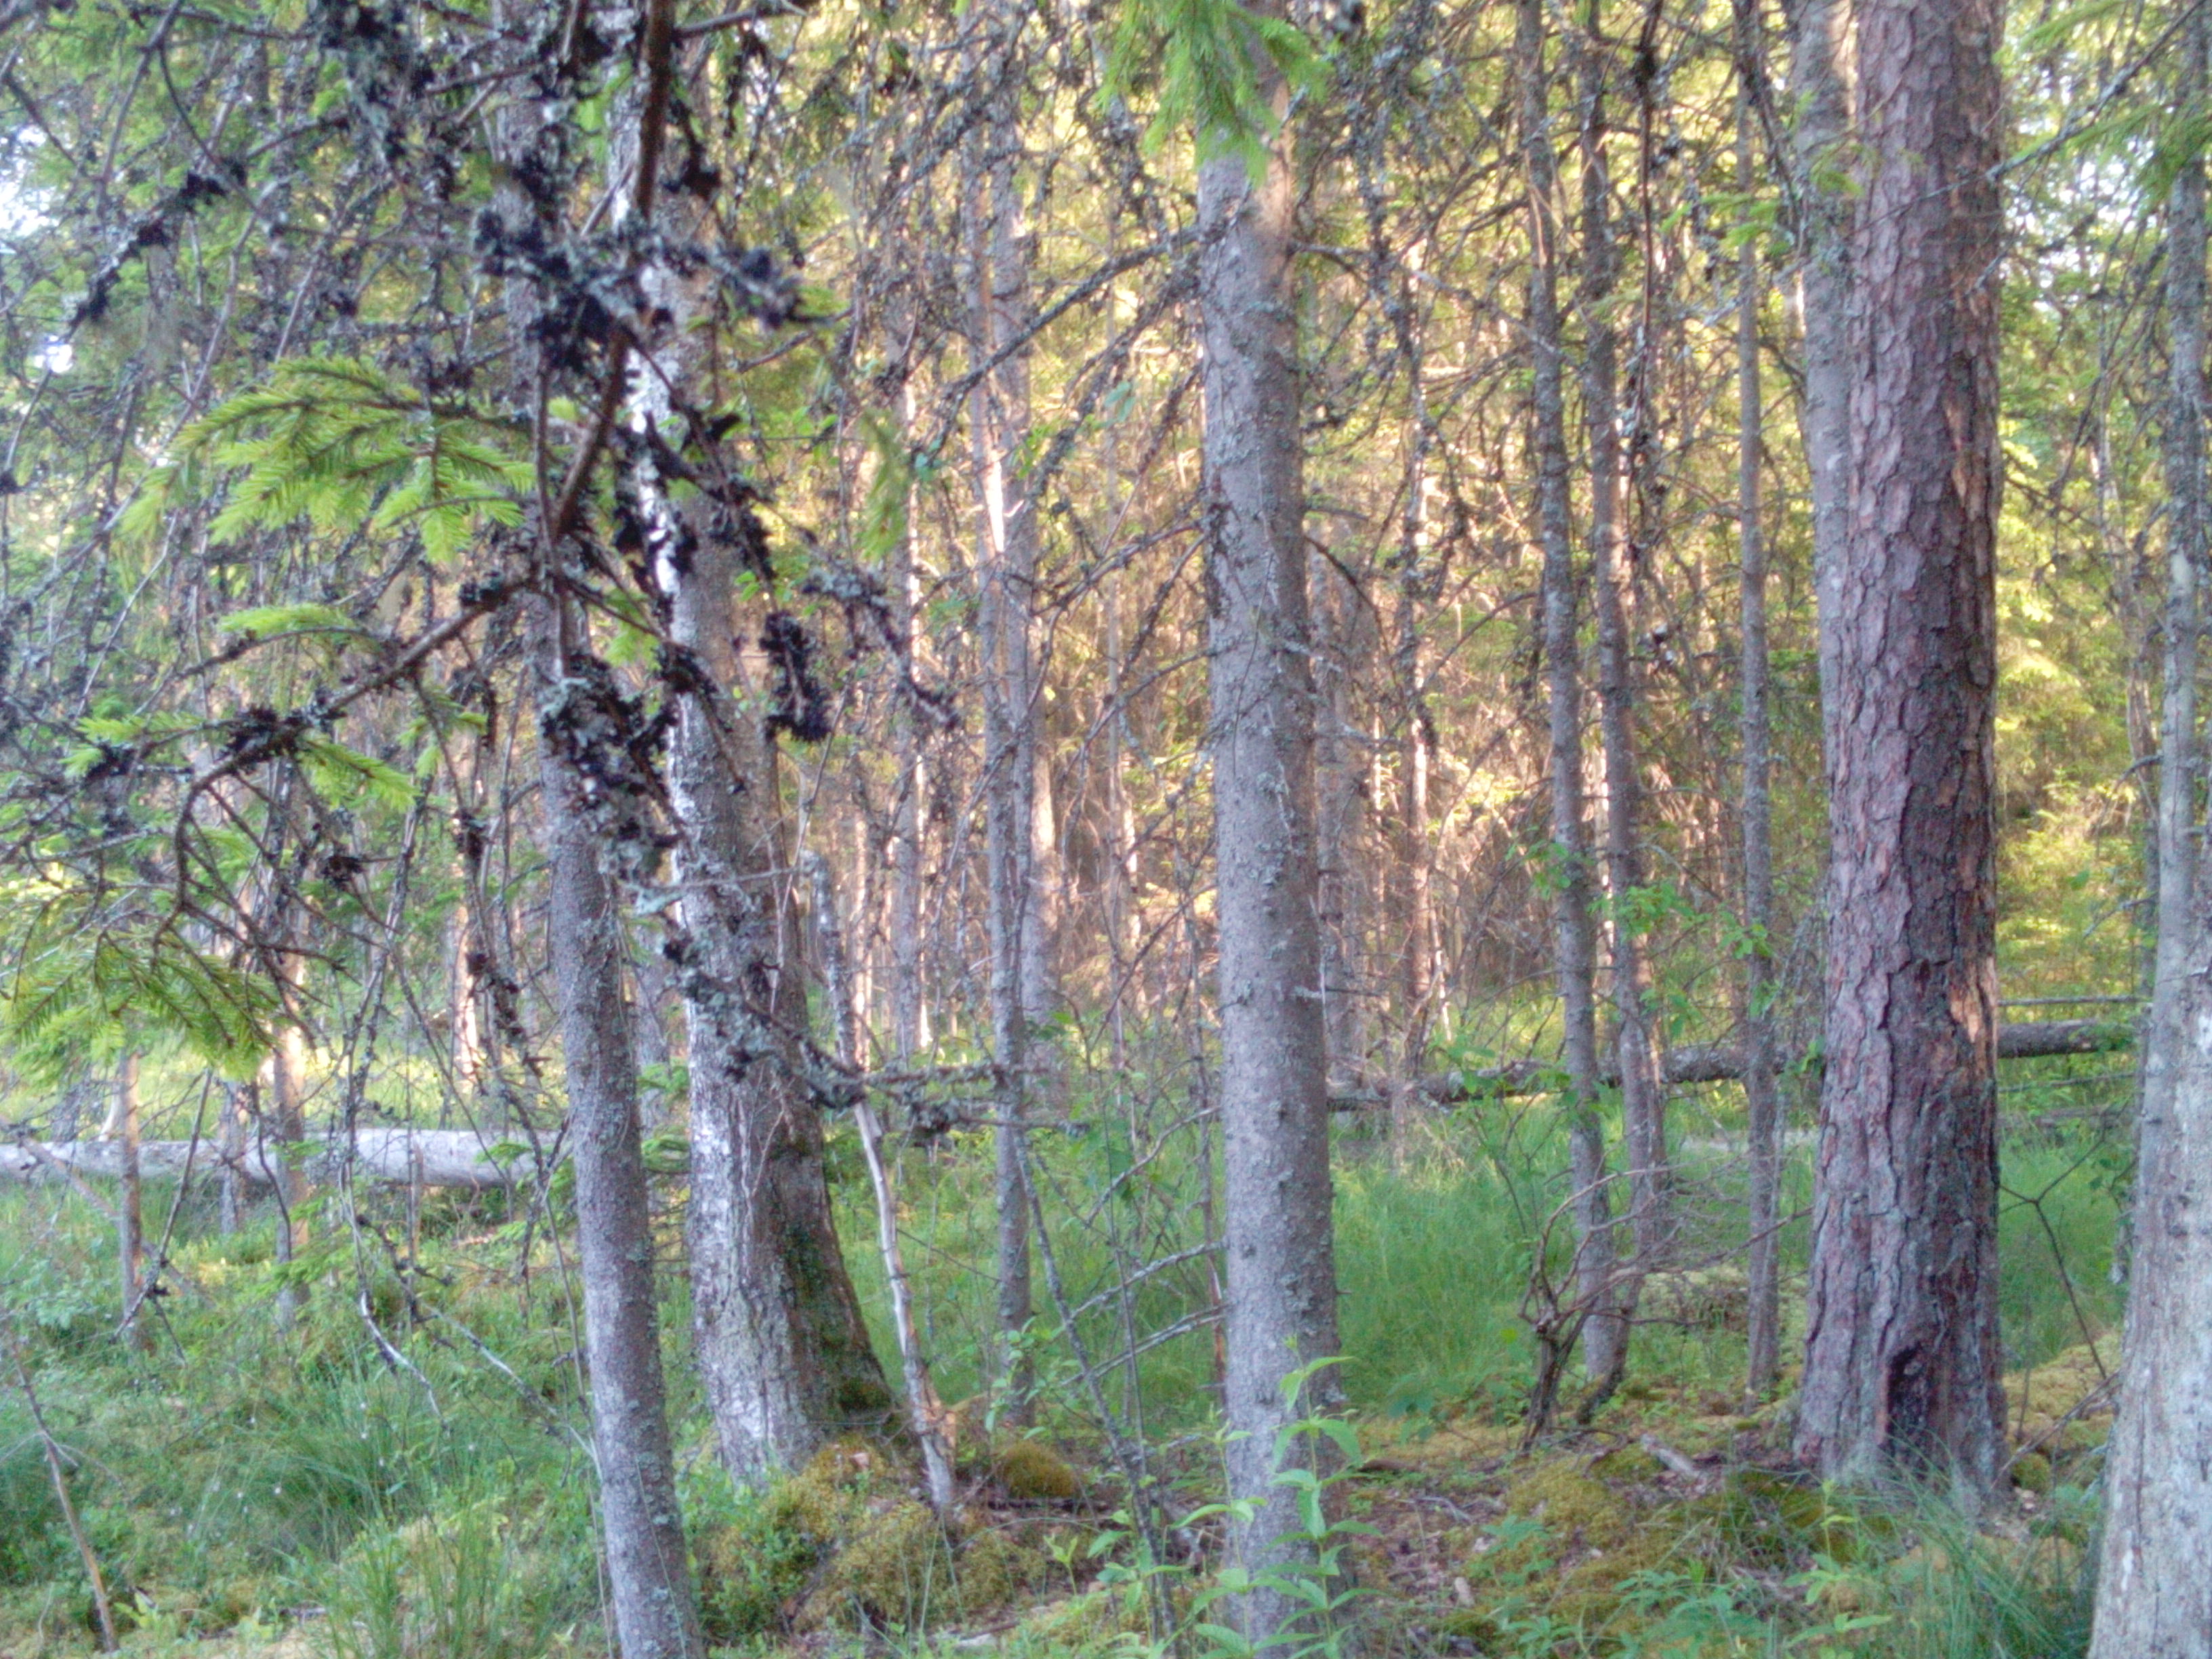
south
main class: Woodland
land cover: Spruce dominated mixed woodland
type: hemiboreal forest and nemoral coniferous forest and mixed broadleaved-coniferous forest
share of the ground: > 75 %
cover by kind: broadleaved forest trees 55 %, coniferous forest trees 25 %, herbaceous plants 15 %, lichens and mosses 5 %
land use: Forestry
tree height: > 5 m
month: July
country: LV
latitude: 56.4735
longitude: 21.8494
